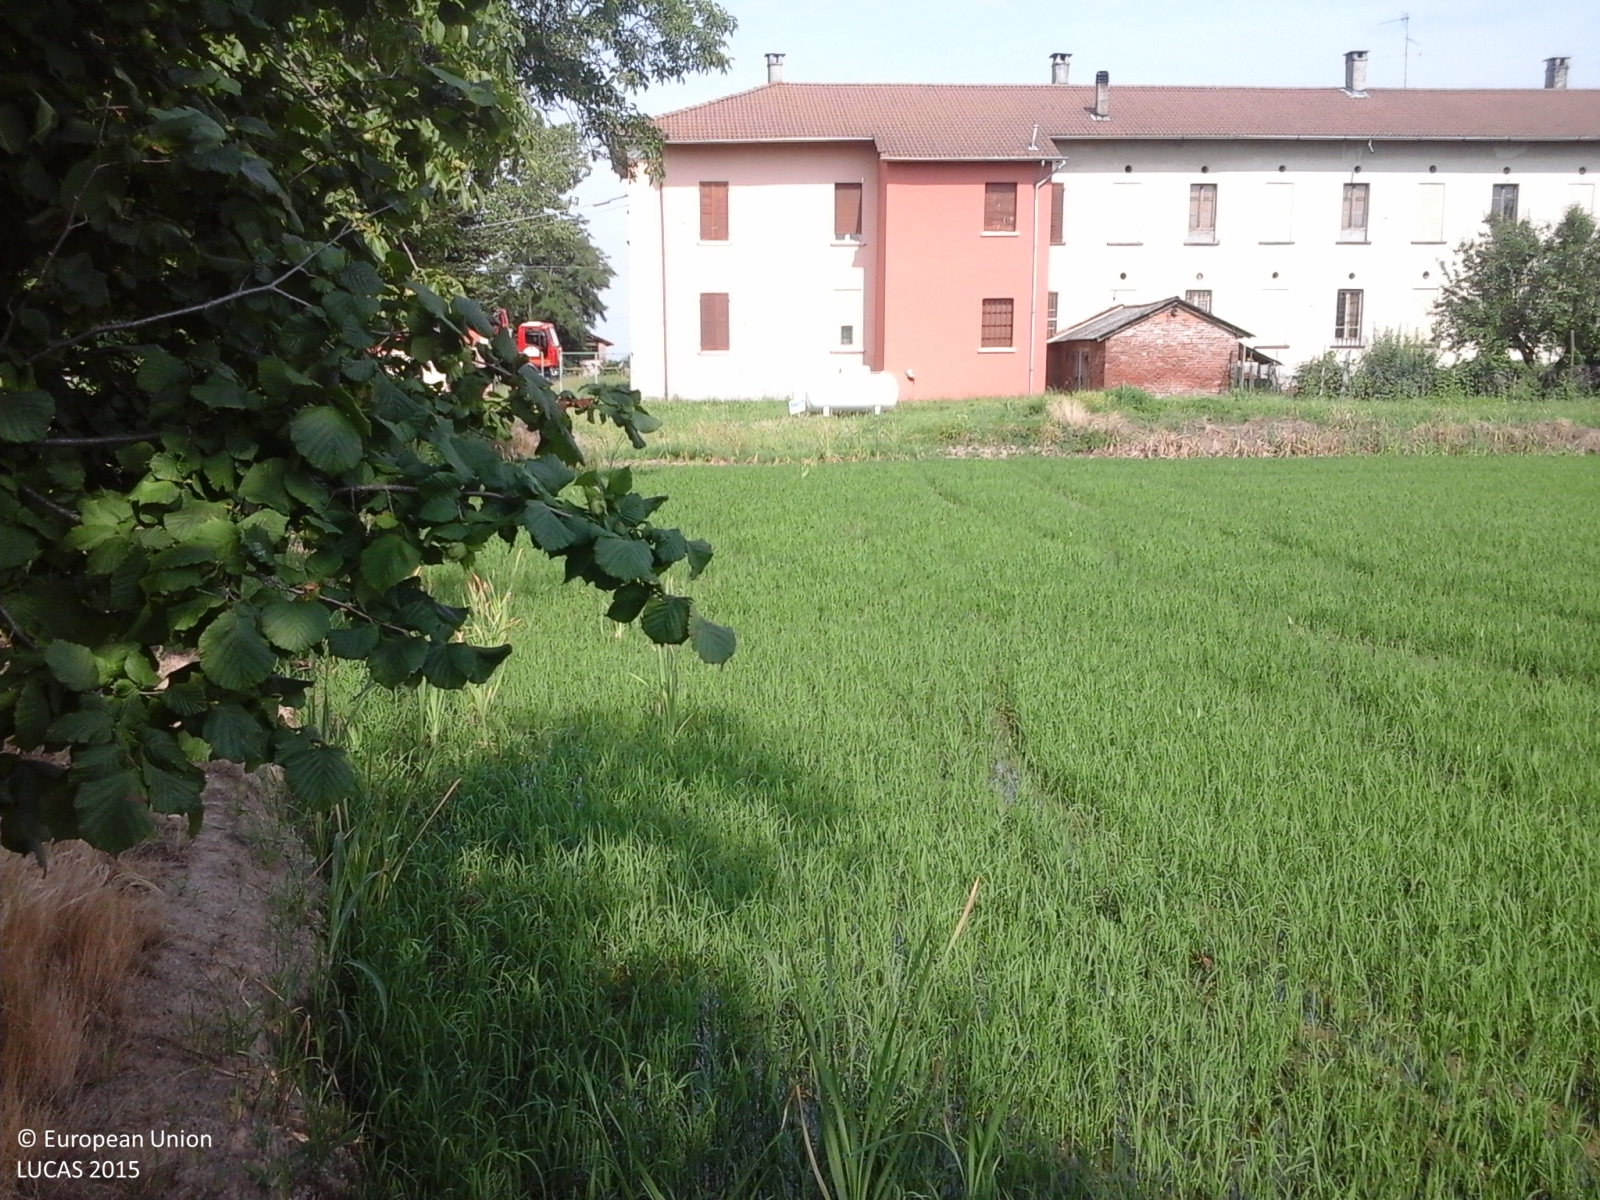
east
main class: Cropland
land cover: Rice
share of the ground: > 75 %
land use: Agriculture (excluding fallow land and kitchen gardens)
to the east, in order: Rice; Grass margins; Ditches and canals; Grass margins; Soya; Artificial constructions in urban areas
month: June
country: IT
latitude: 45.3694
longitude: 8.6362
